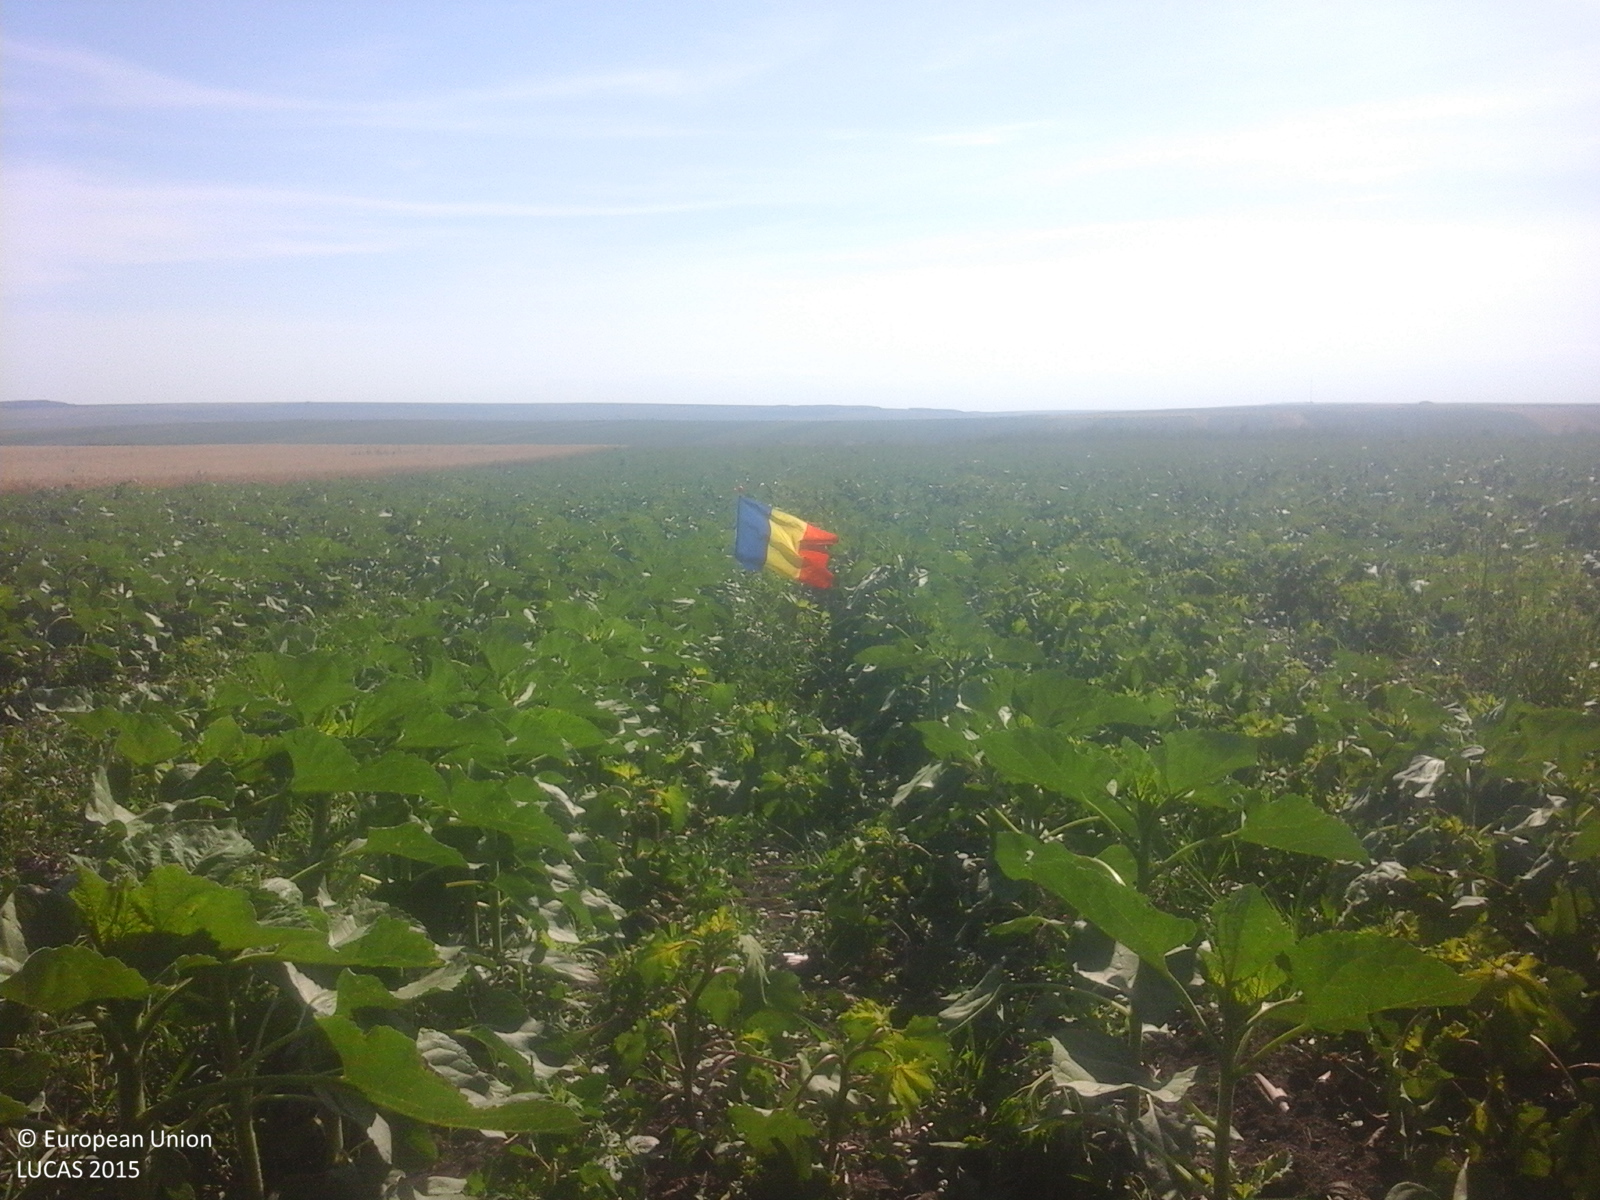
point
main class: Cropland
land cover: Sunflower
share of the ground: 50 - 75 %
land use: Agriculture (excluding fallow land and kitchen gardens)
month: June
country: RO
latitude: 47.9577
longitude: 26.9929
